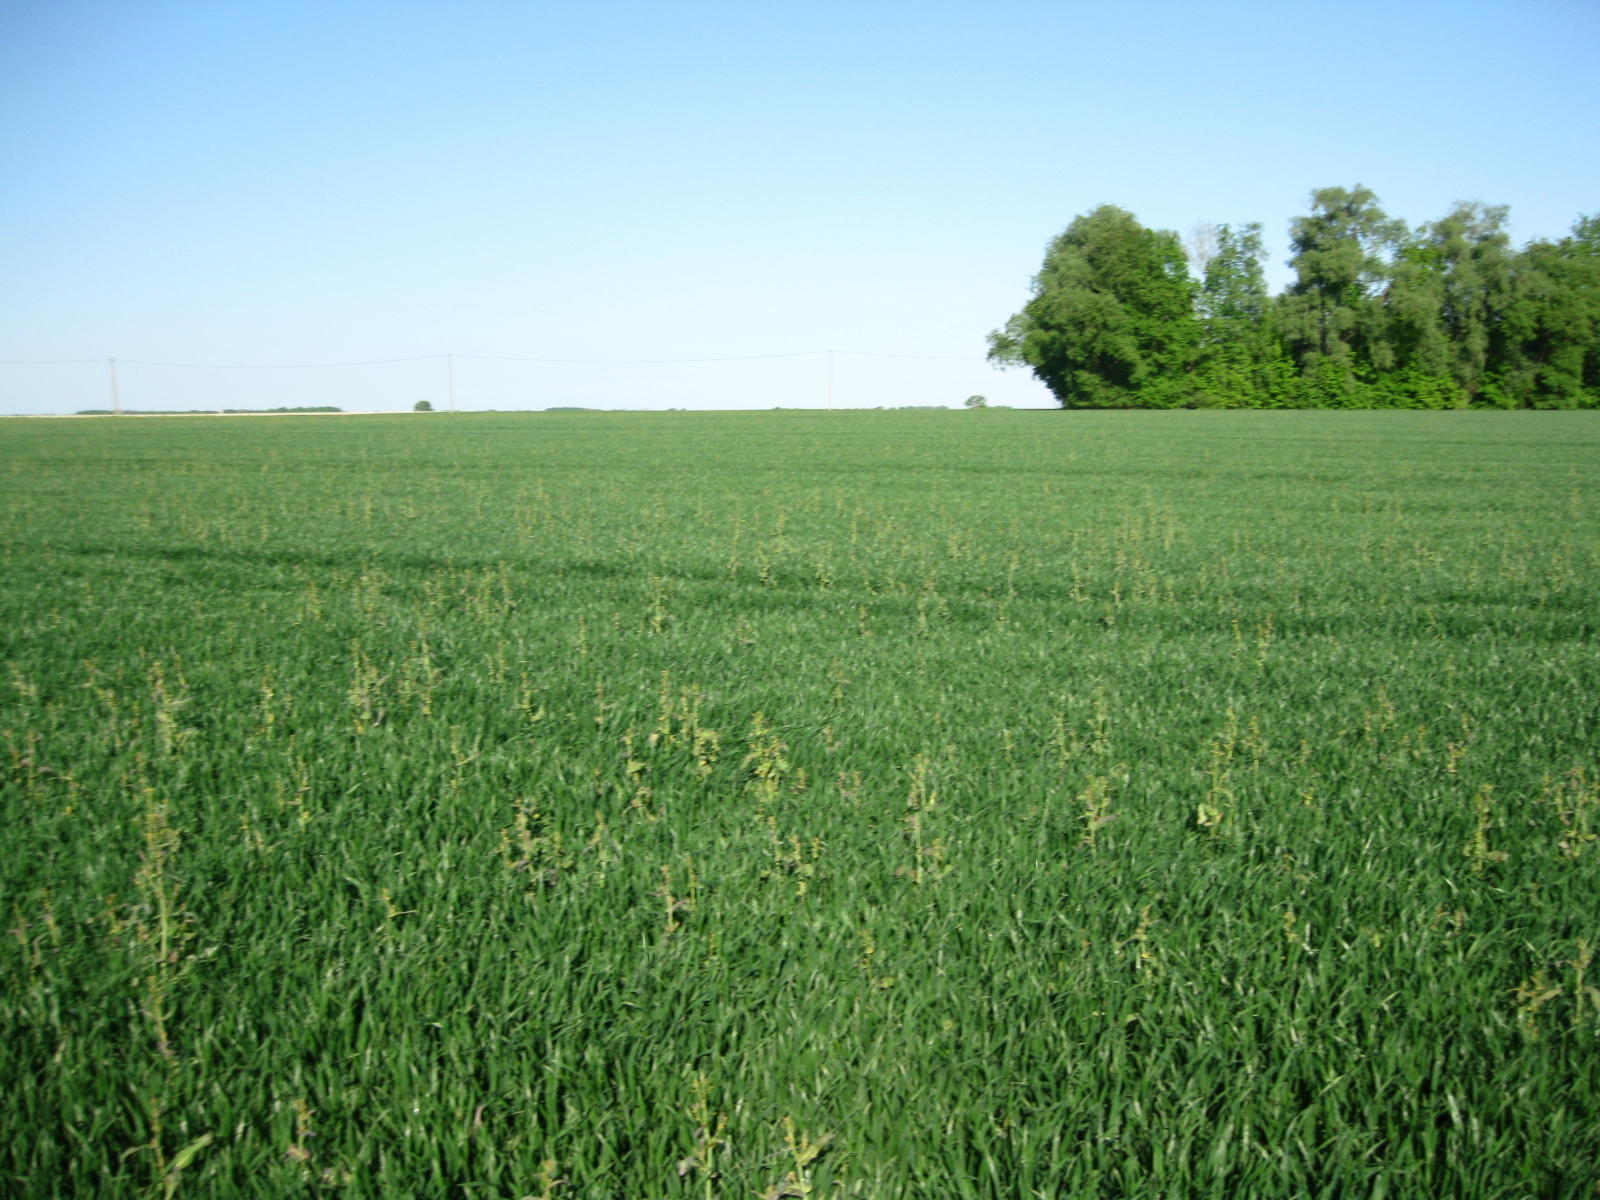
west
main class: Cropland
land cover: Common wheat
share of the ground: > 75 %
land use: Agriculture (excluding fallow land and kitchen gardens)
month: May
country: LT
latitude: 56.0750
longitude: 24.1478
